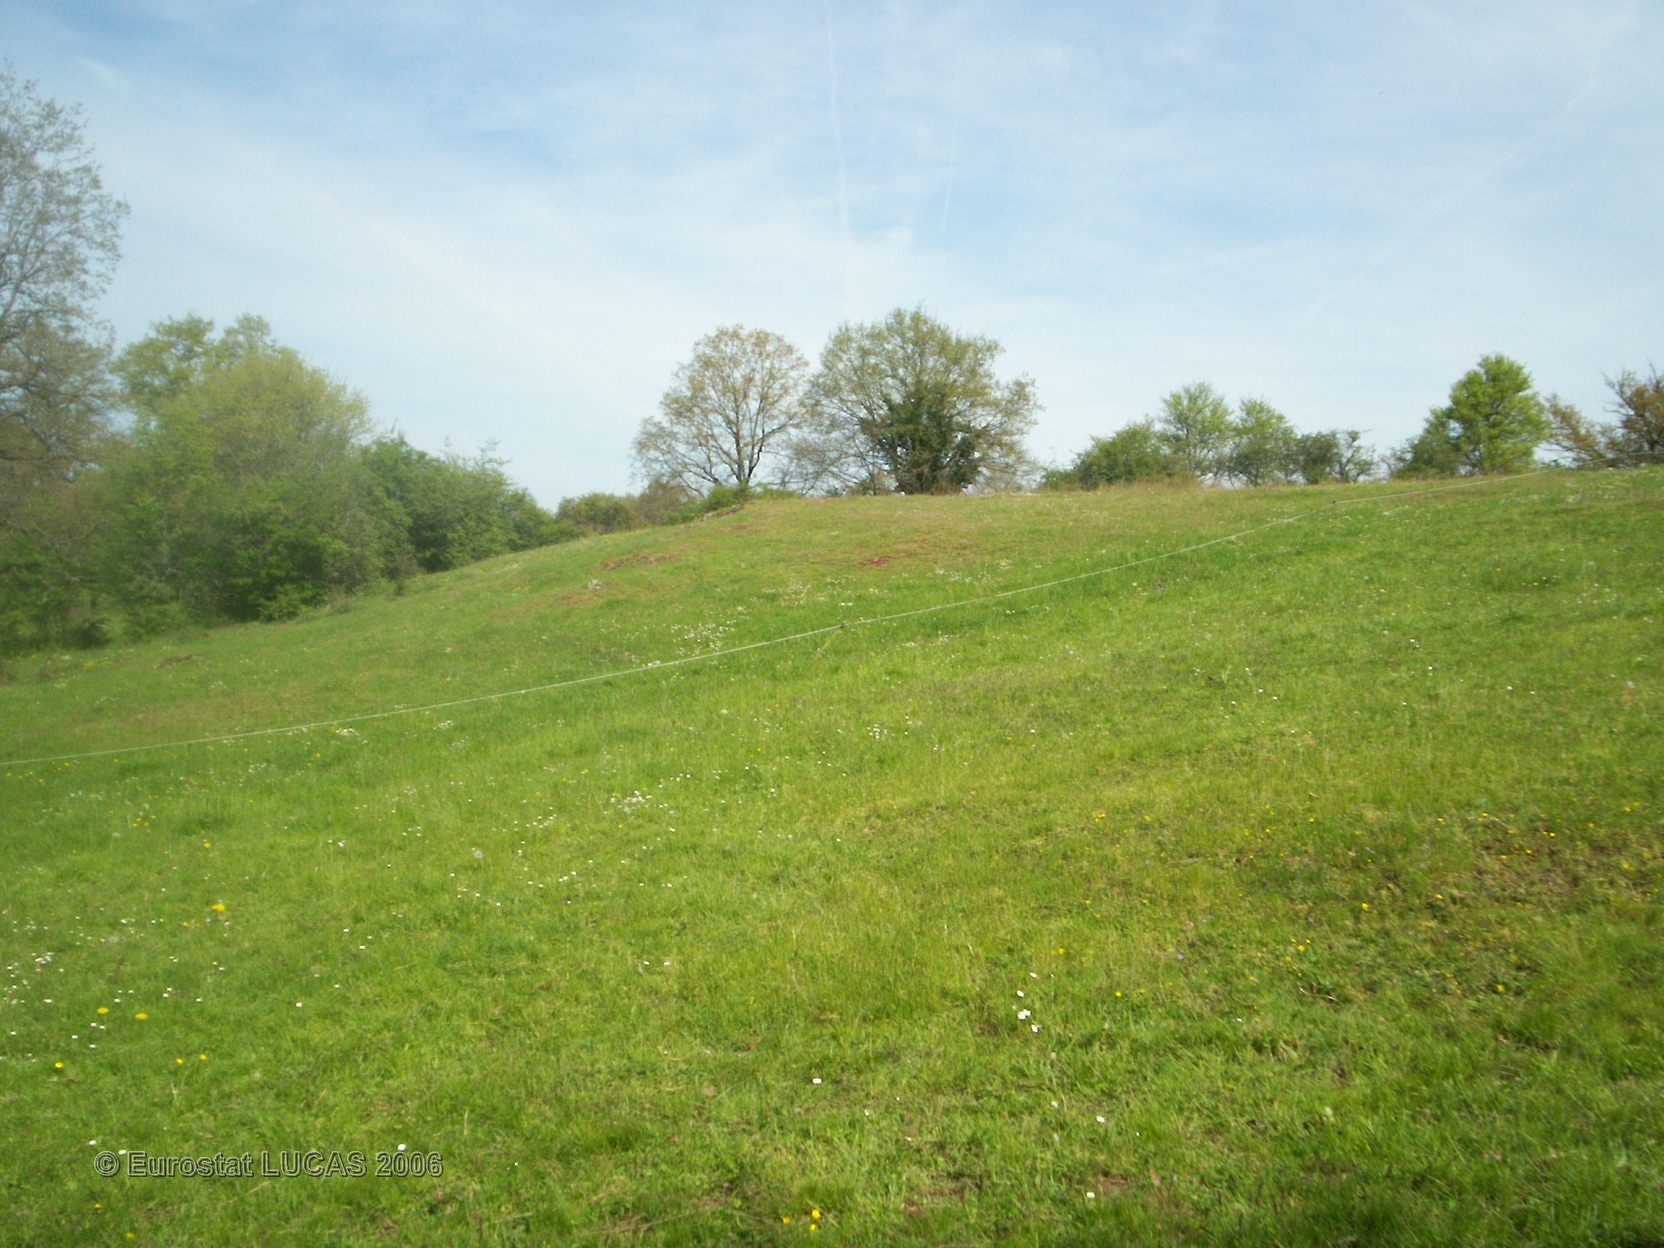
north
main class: Grassland
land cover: Grassland without tree/shrub cover
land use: Agriculture (excluding fallow land and kitchen gardens)
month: May
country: FR
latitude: 46.3859
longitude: 3.1715
